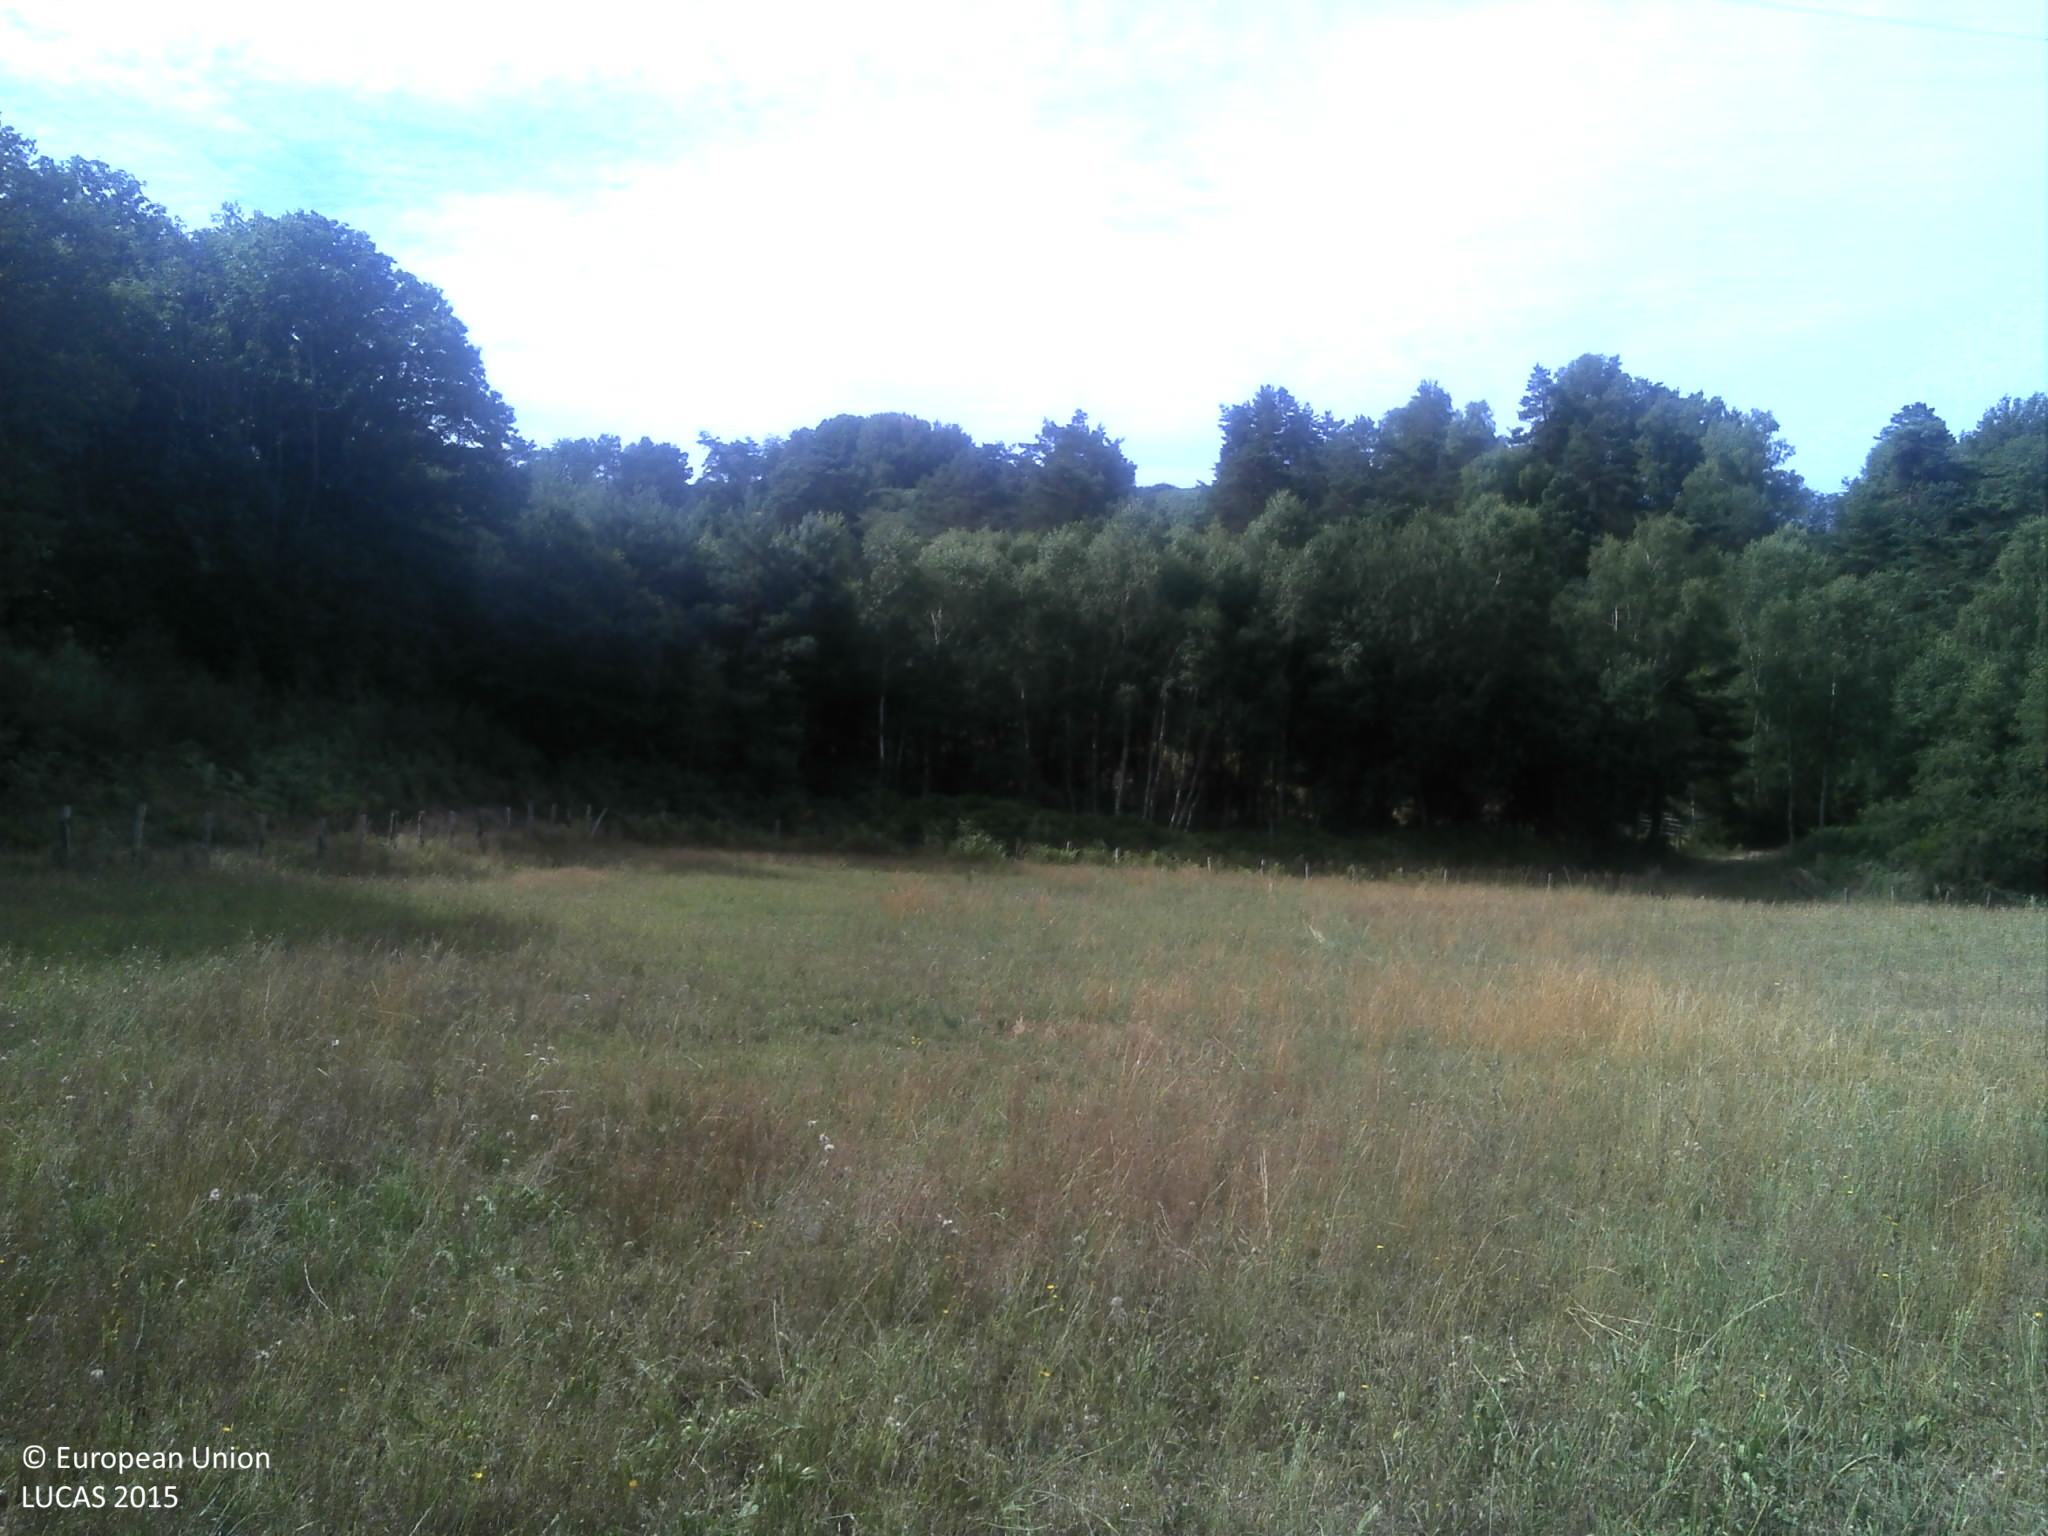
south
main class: Grassland
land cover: Grassland without tree/shrub cover
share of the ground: > 75 %
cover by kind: herbaceous plants 100 %
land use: Agriculture (excluding fallow land and kitchen gardens)
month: July
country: FR
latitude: 45.1841
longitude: 1.7878
